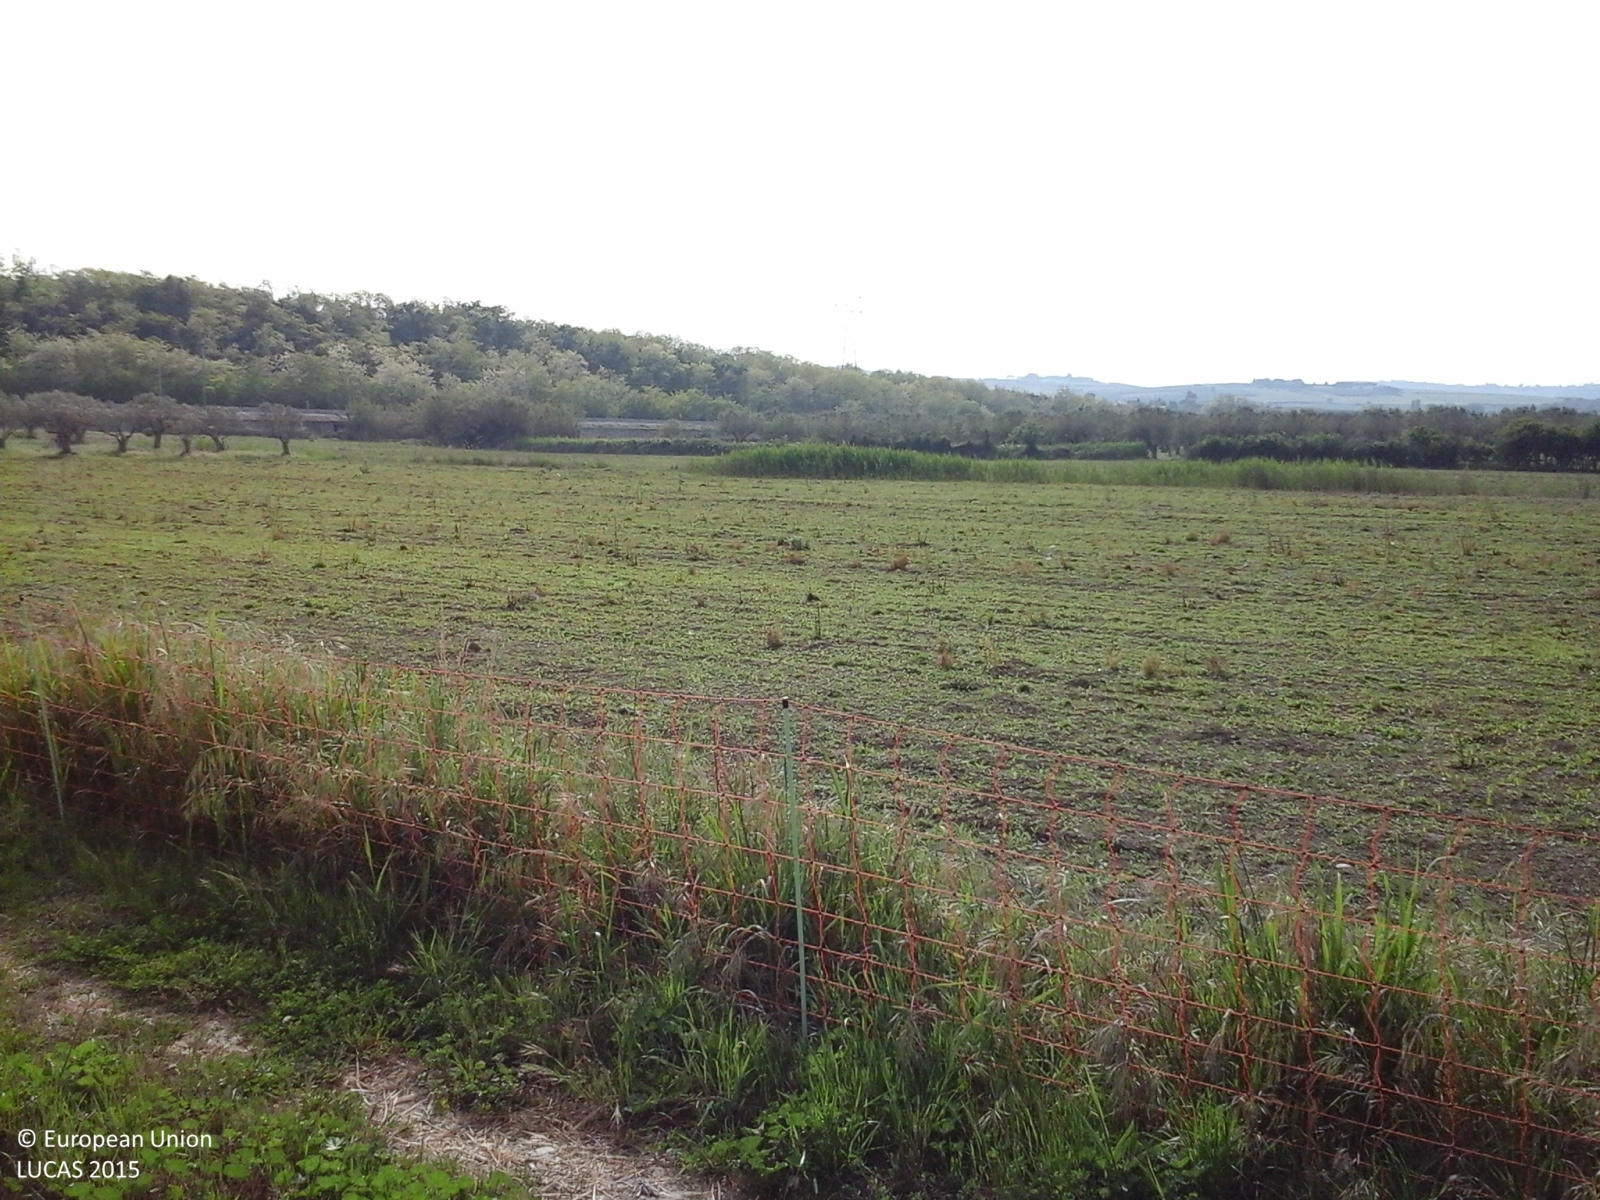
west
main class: Cropland
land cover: Durum wheat
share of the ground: > 75 %
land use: Agriculture (excluding fallow land and kitchen gardens)
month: May
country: IT
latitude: 42.0717
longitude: 14.7596
